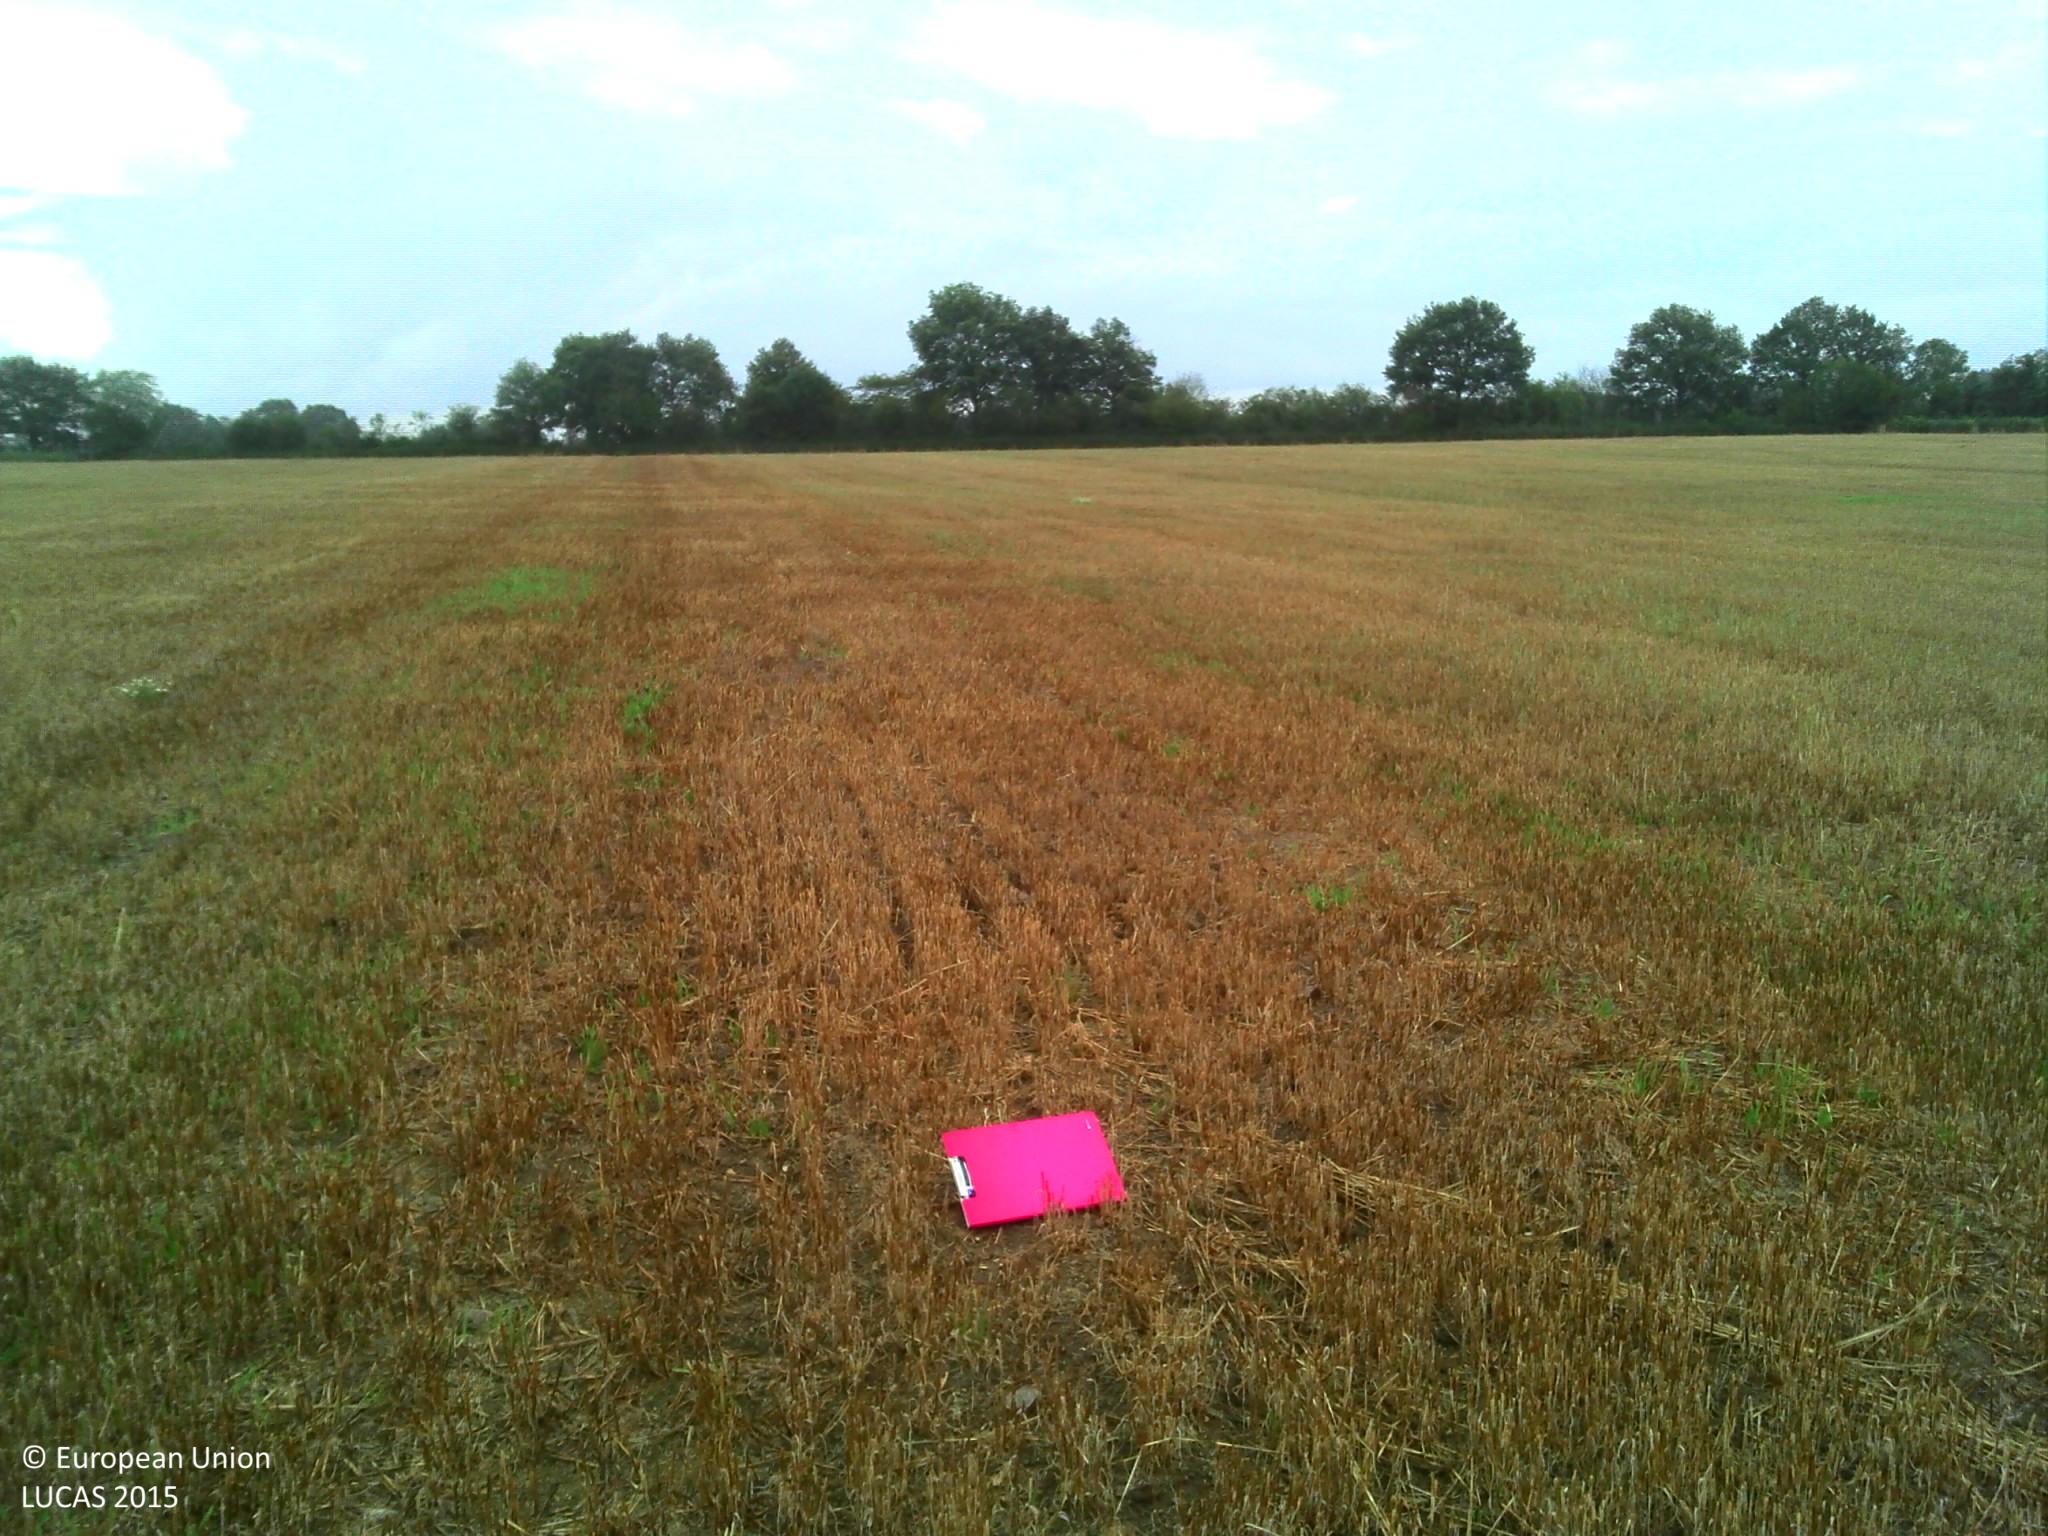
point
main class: Cropland
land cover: Barley
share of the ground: 50 - 75 %
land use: Agriculture (excluding fallow land and kitchen gardens)
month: August
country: FR
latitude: 46.2403
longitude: 2.3567
